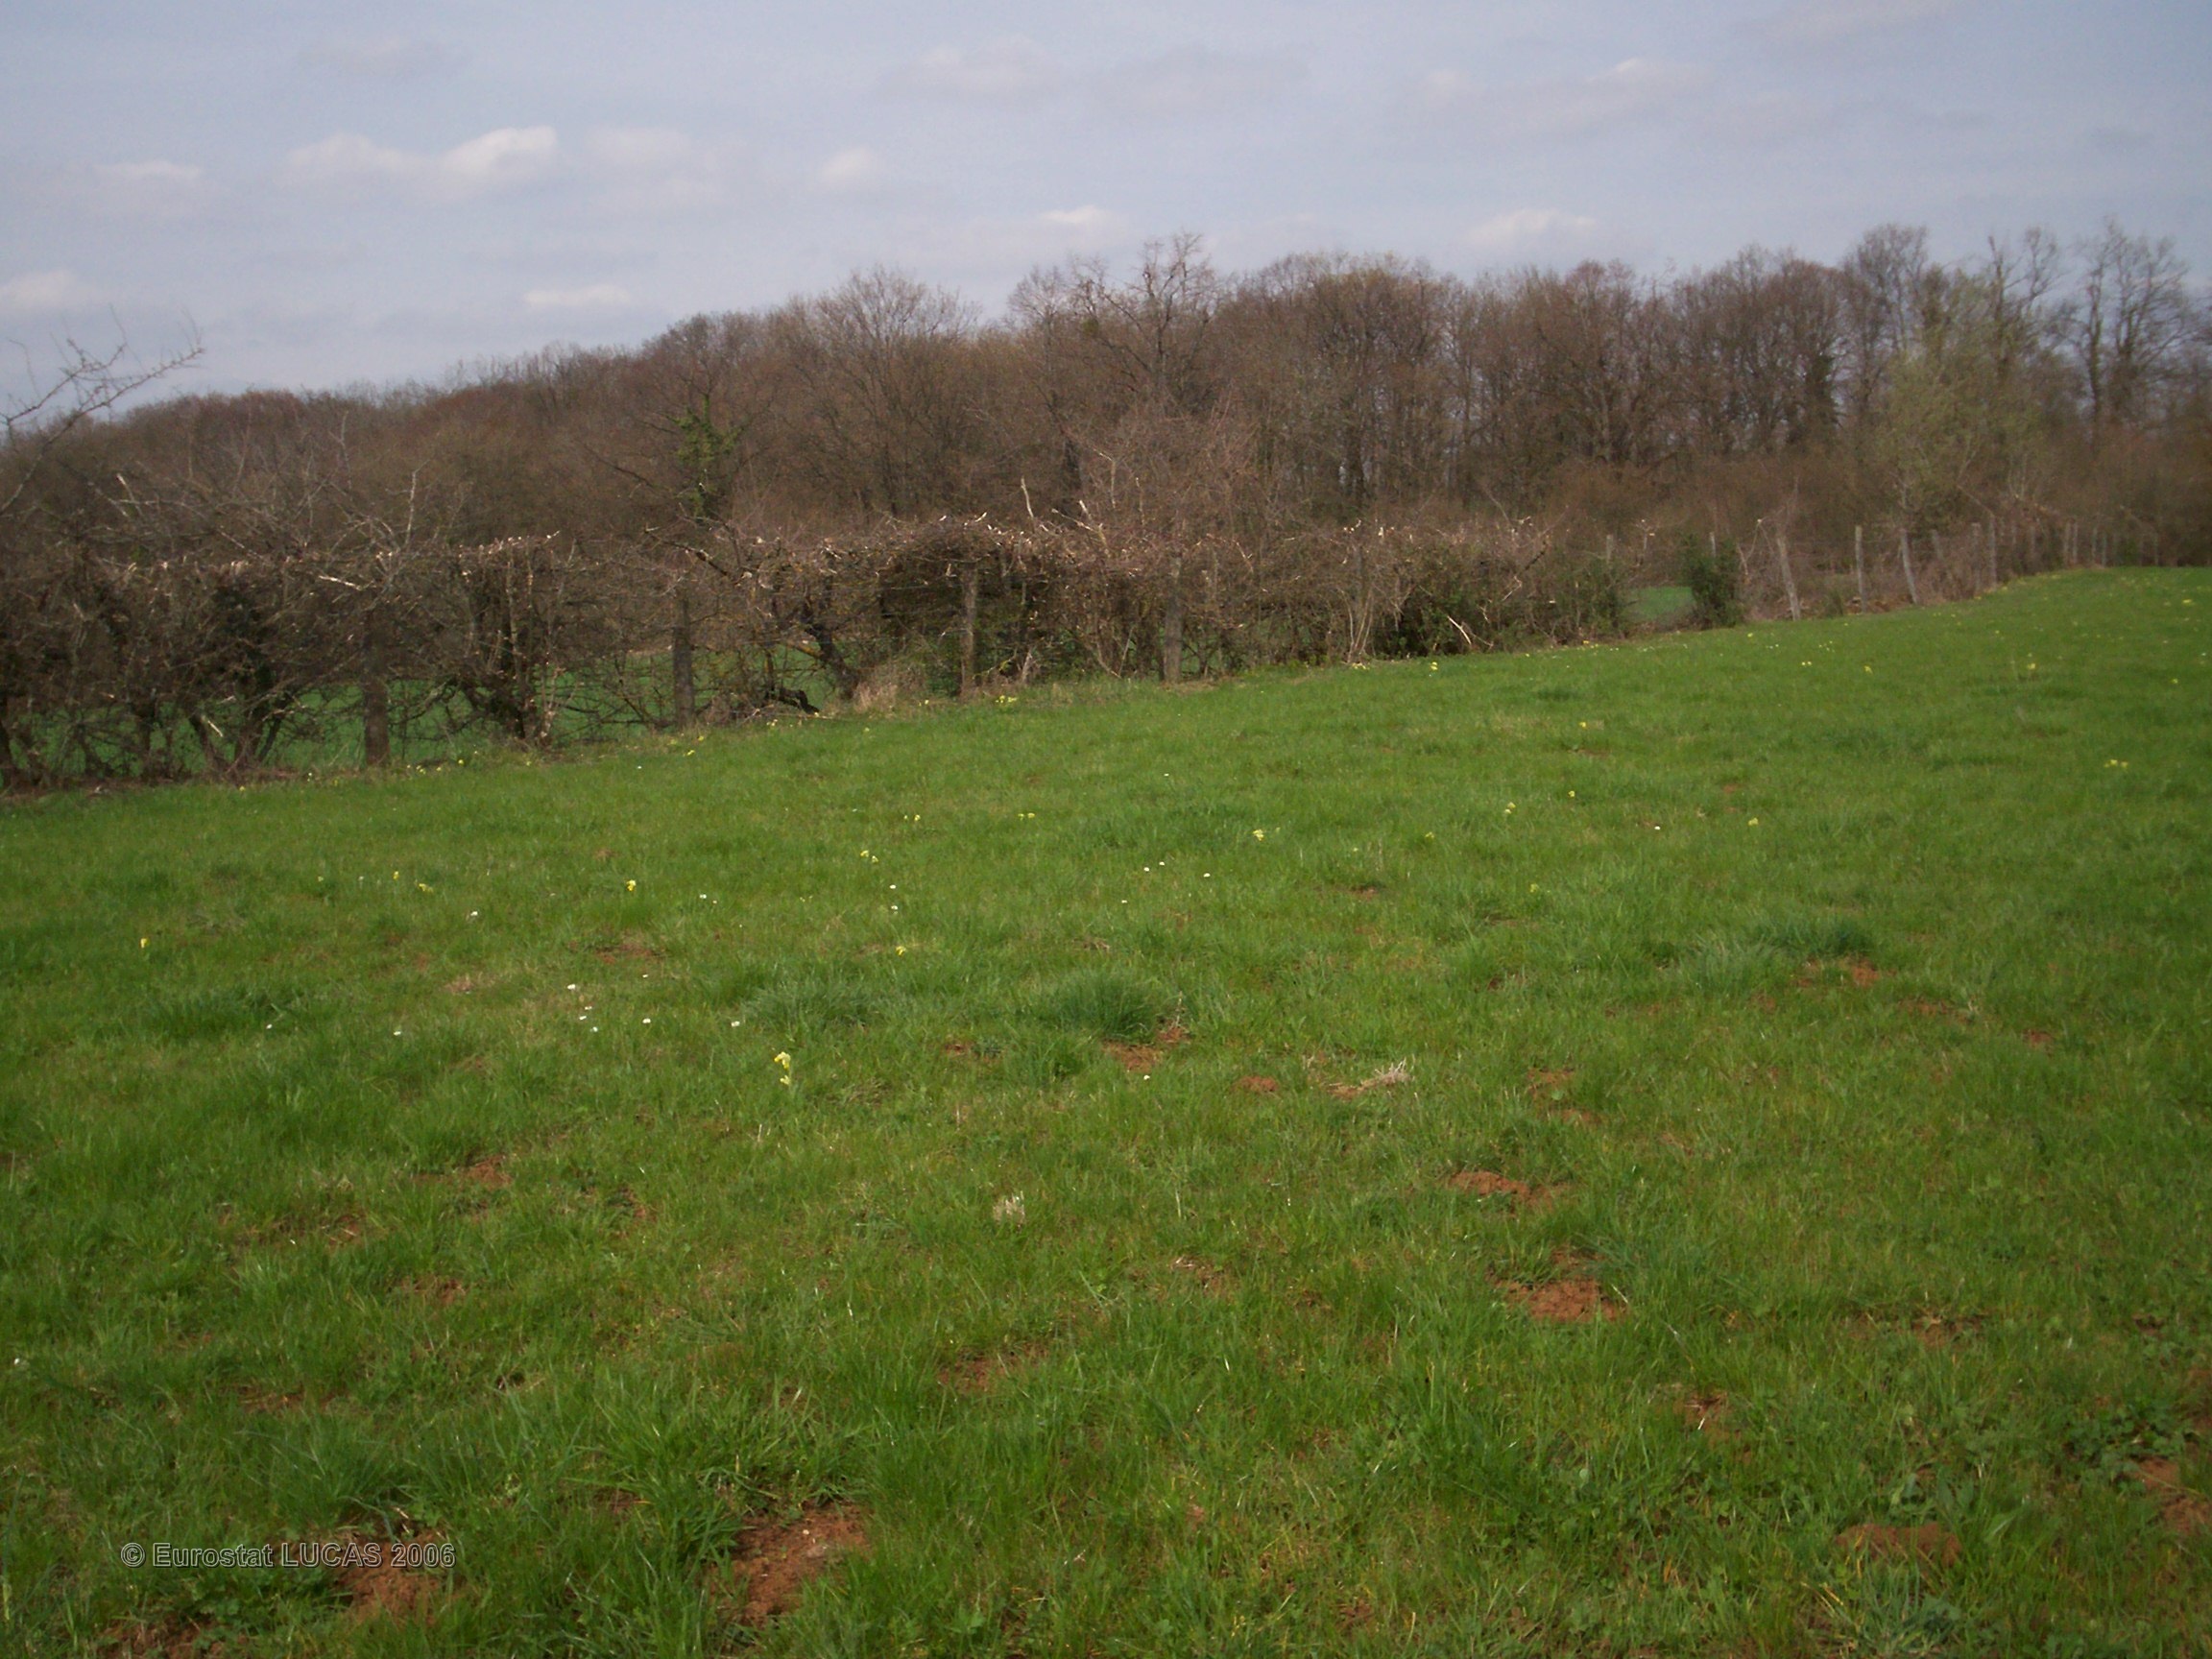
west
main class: Grassland
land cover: Grassland without tree/shrub cover
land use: Agriculture (excluding fallow land and kitchen gardens)
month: April
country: FR
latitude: 47.7983
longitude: 5.2872
